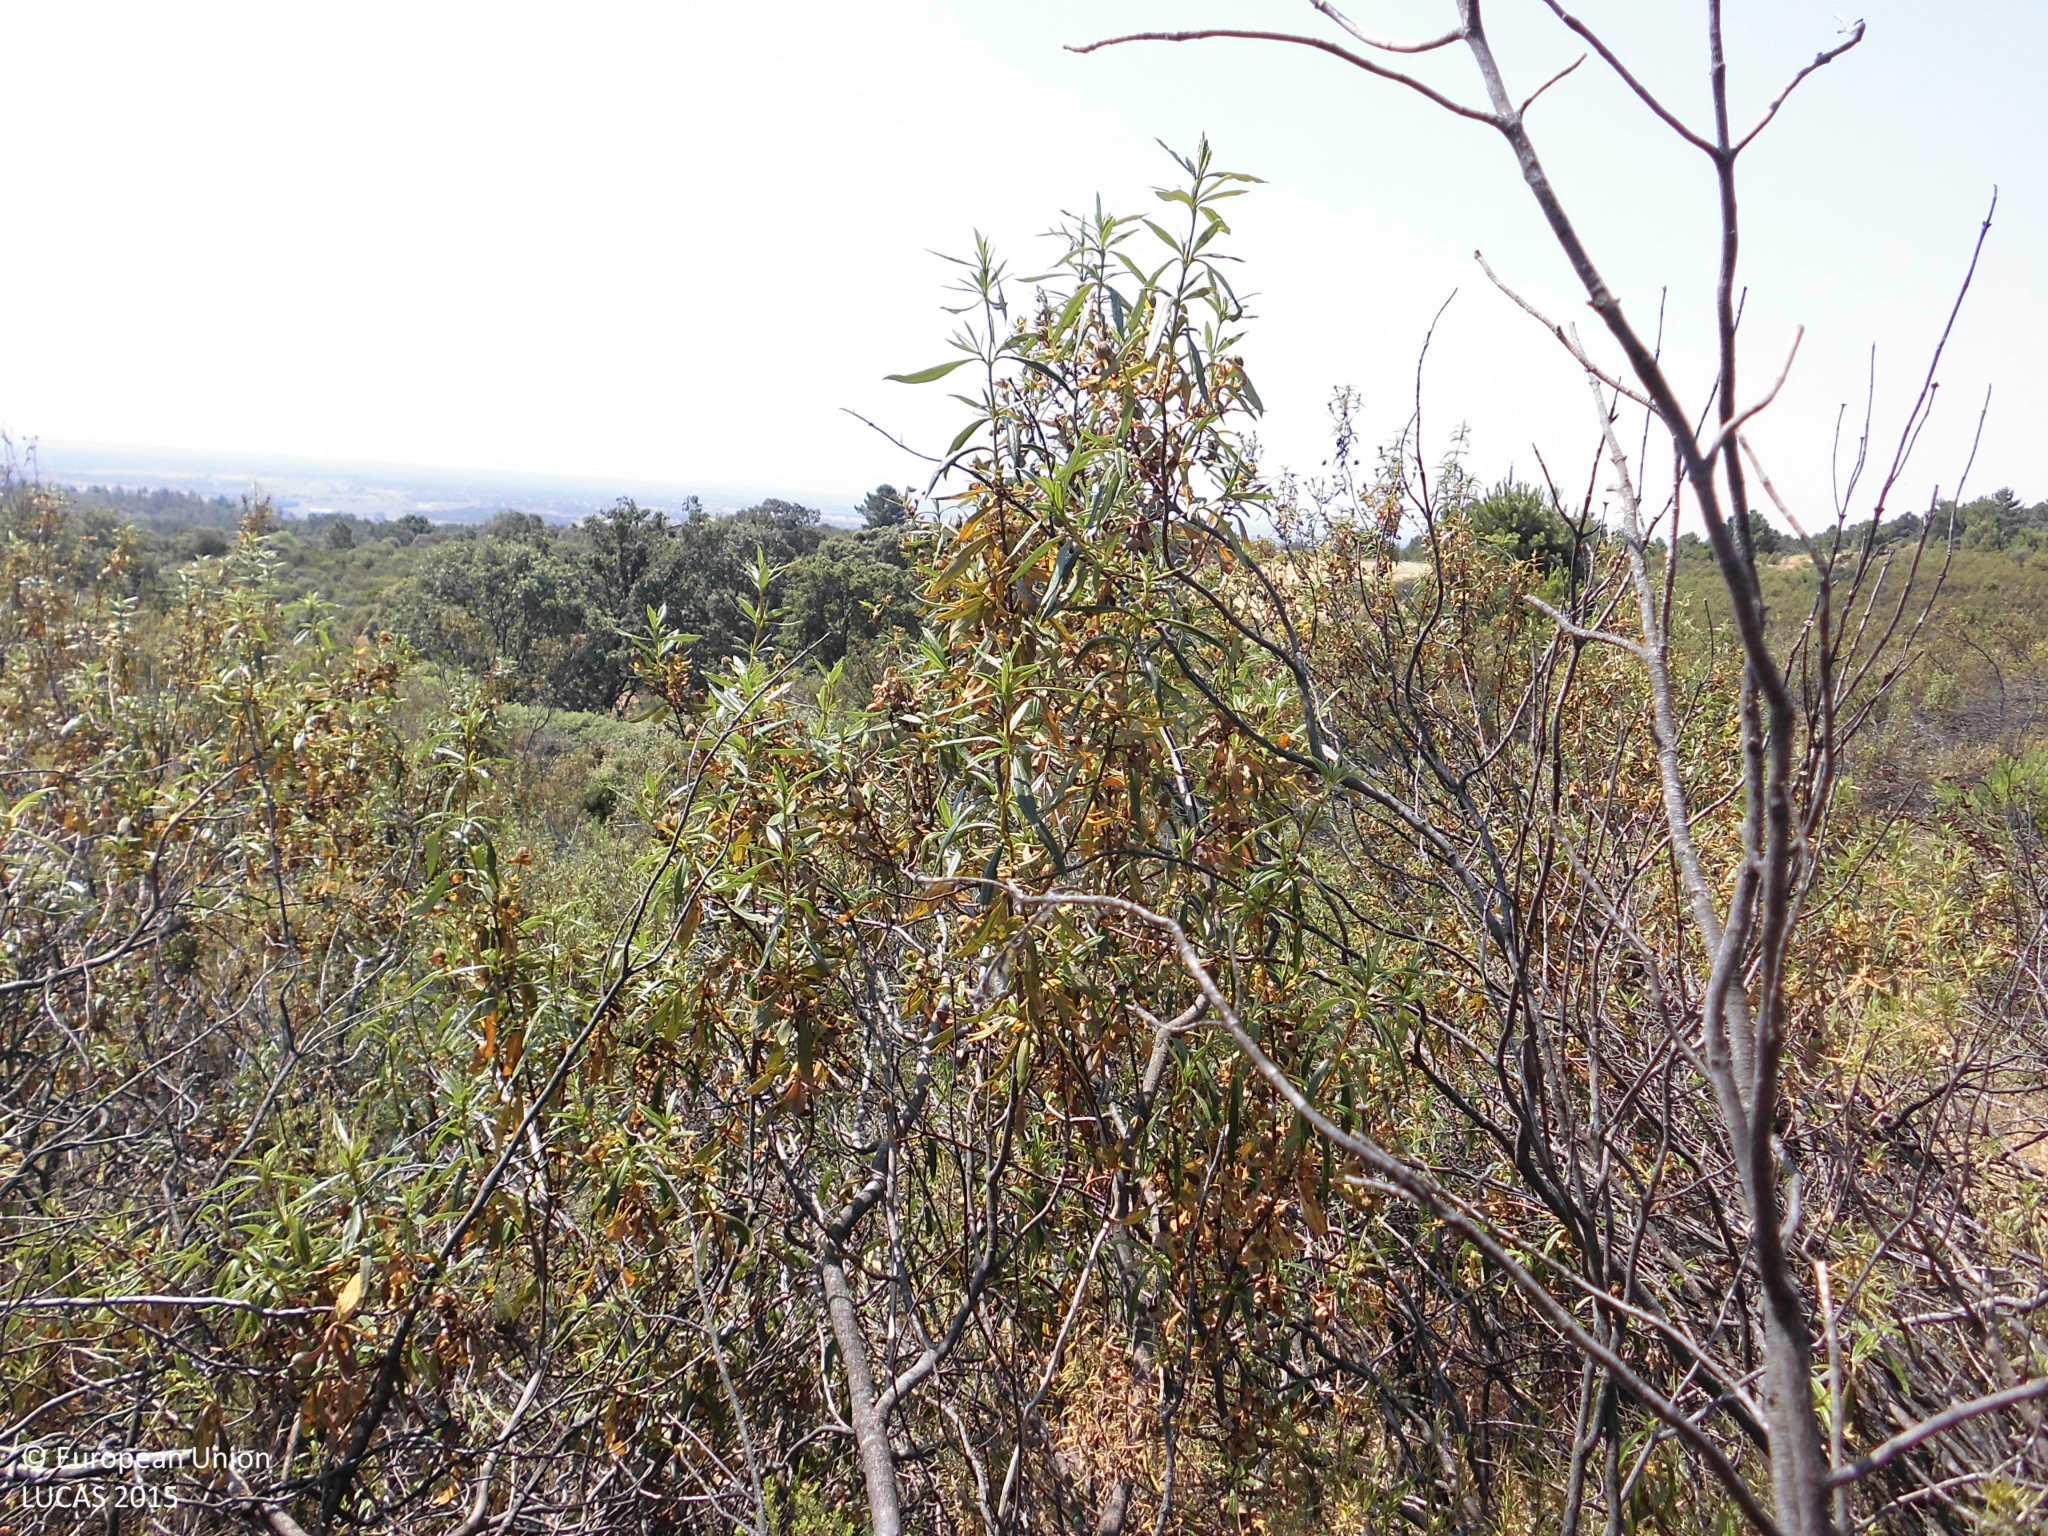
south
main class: Shrubland
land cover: Shrubland without tree cover
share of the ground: > 75 %
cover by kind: shrubs 90 %, herbaceous plants 10 %
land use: Abandoned areas
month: June
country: ES
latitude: 40.0956
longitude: -5.4855
